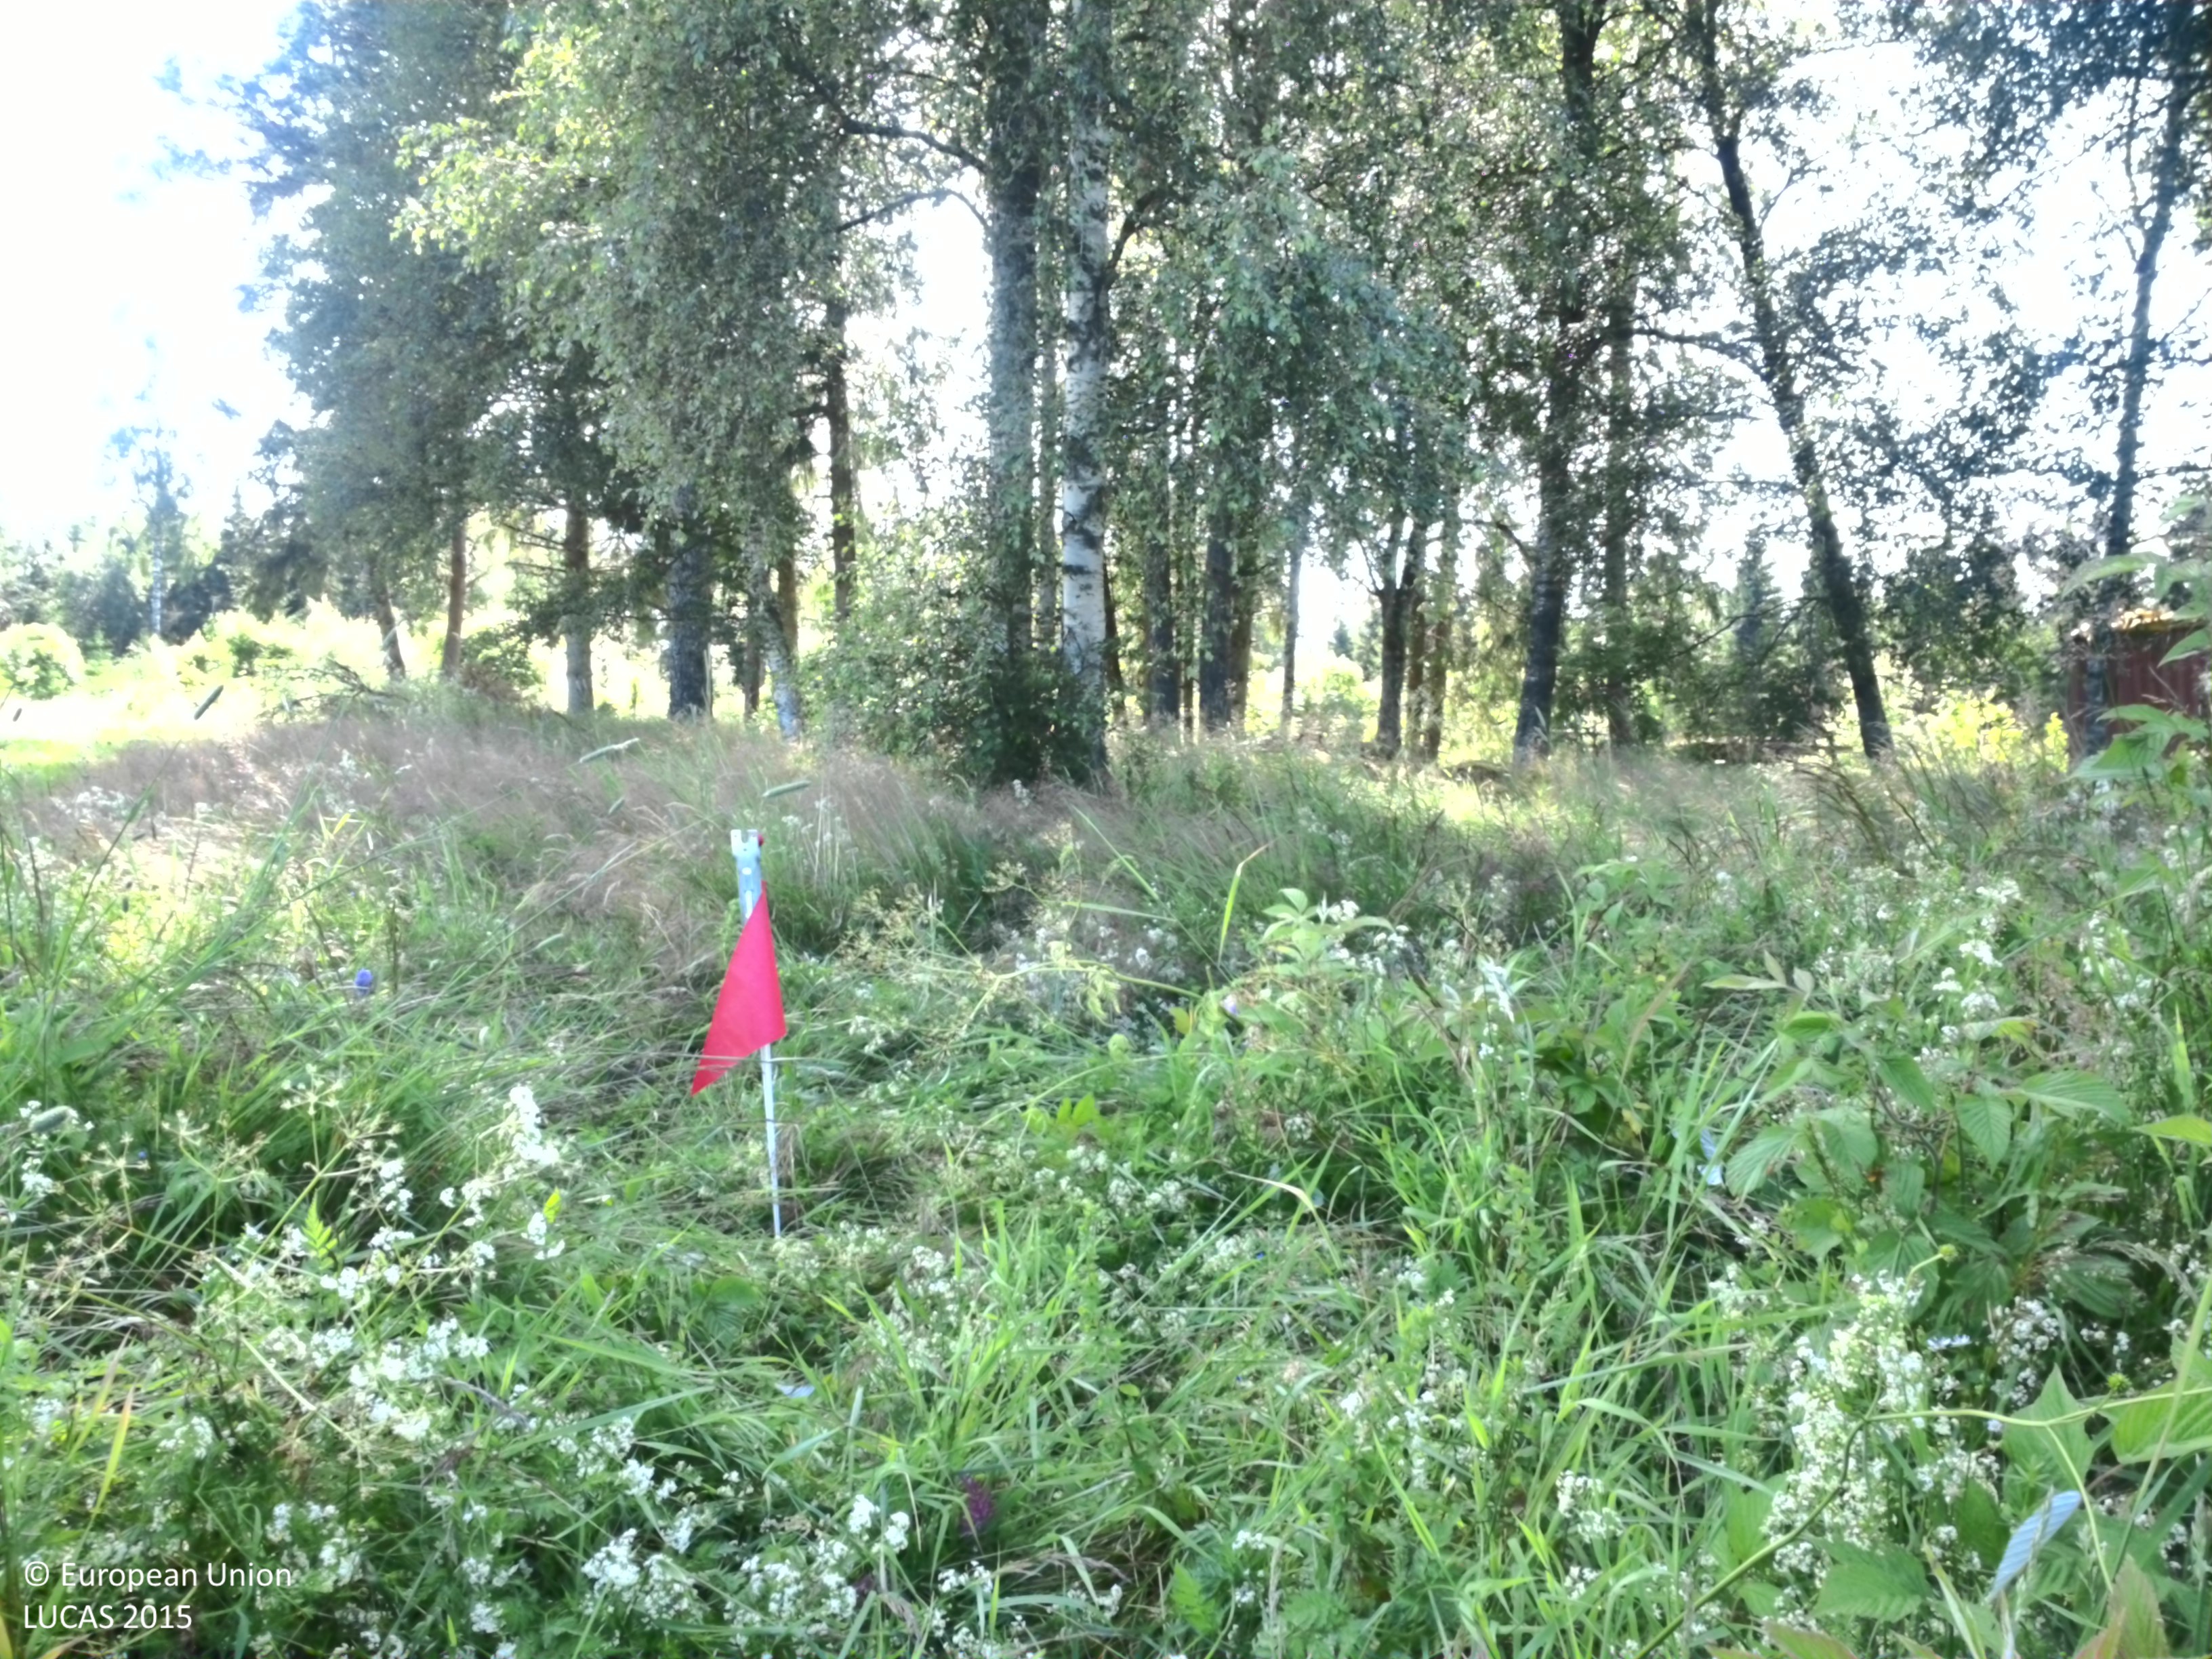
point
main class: Grassland
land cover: Grassland with sparse tree/shrub cover
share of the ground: > 75 %
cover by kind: herbaceous plants 90 %, broadleaved forest trees 5 %, shrubs 5 %
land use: Agriculture (excluding fallow land and kitchen gardens)
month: July
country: SE
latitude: 57.6274
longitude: 14.3324
